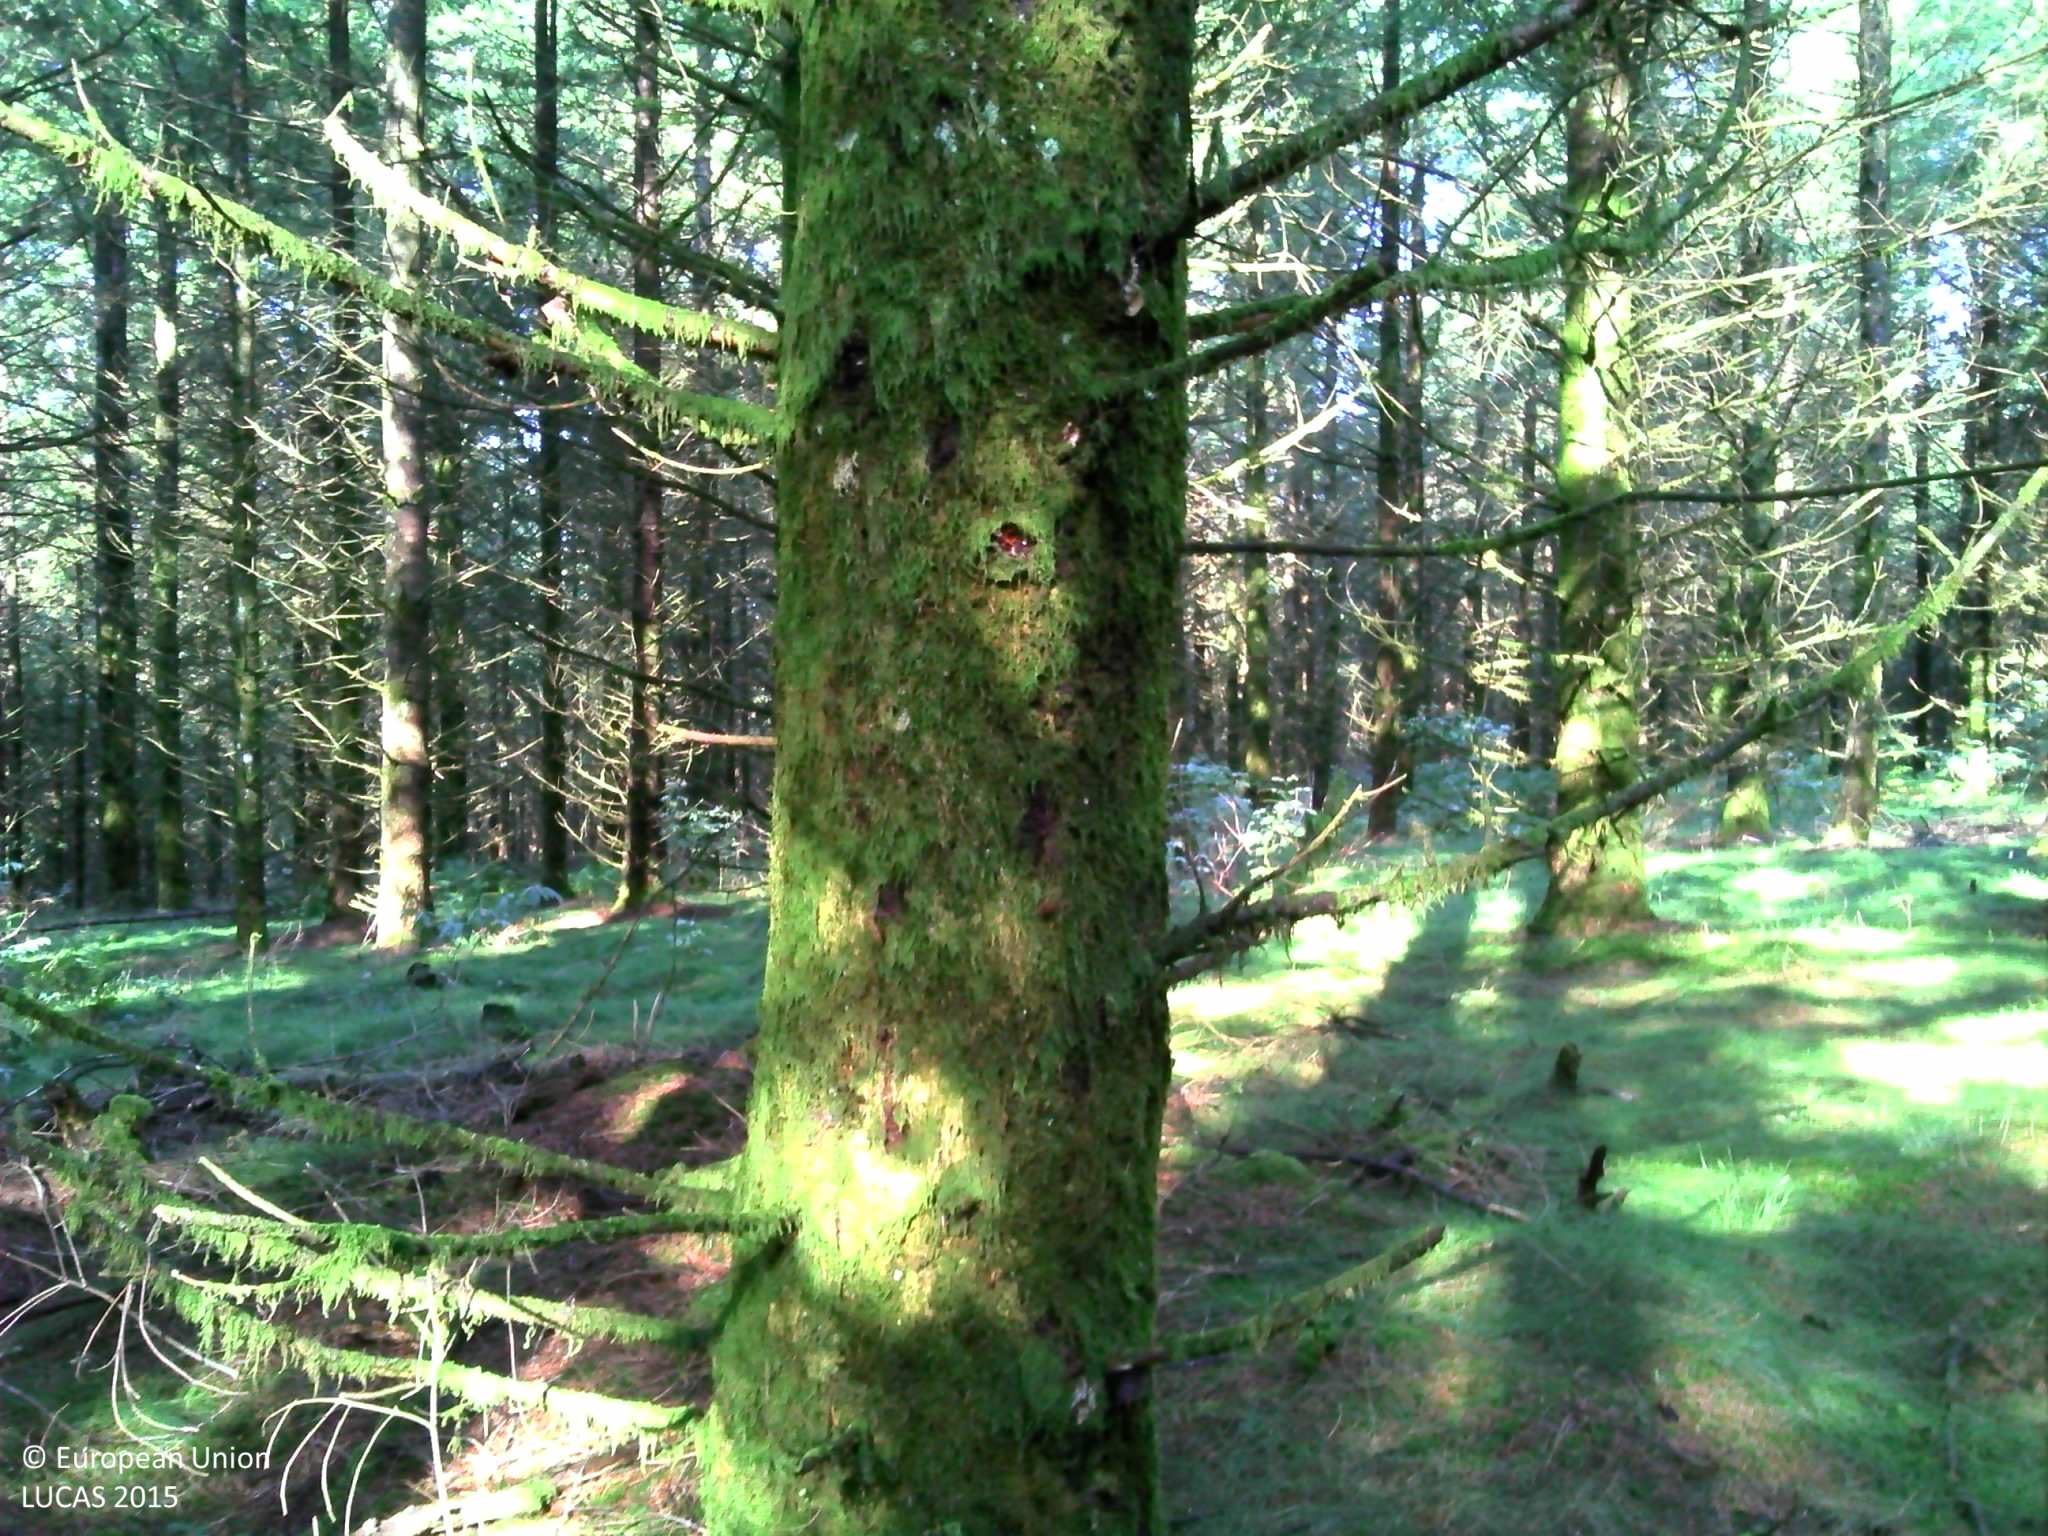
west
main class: Woodland
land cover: Spruce dominated coniferous woodland
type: exotic forest
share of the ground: > 75 %
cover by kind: coniferous forest trees 70 %, herbaceous plants 30 %
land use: Forestry
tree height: > 5 m
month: August
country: FR
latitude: 45.5341
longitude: 1.8640
